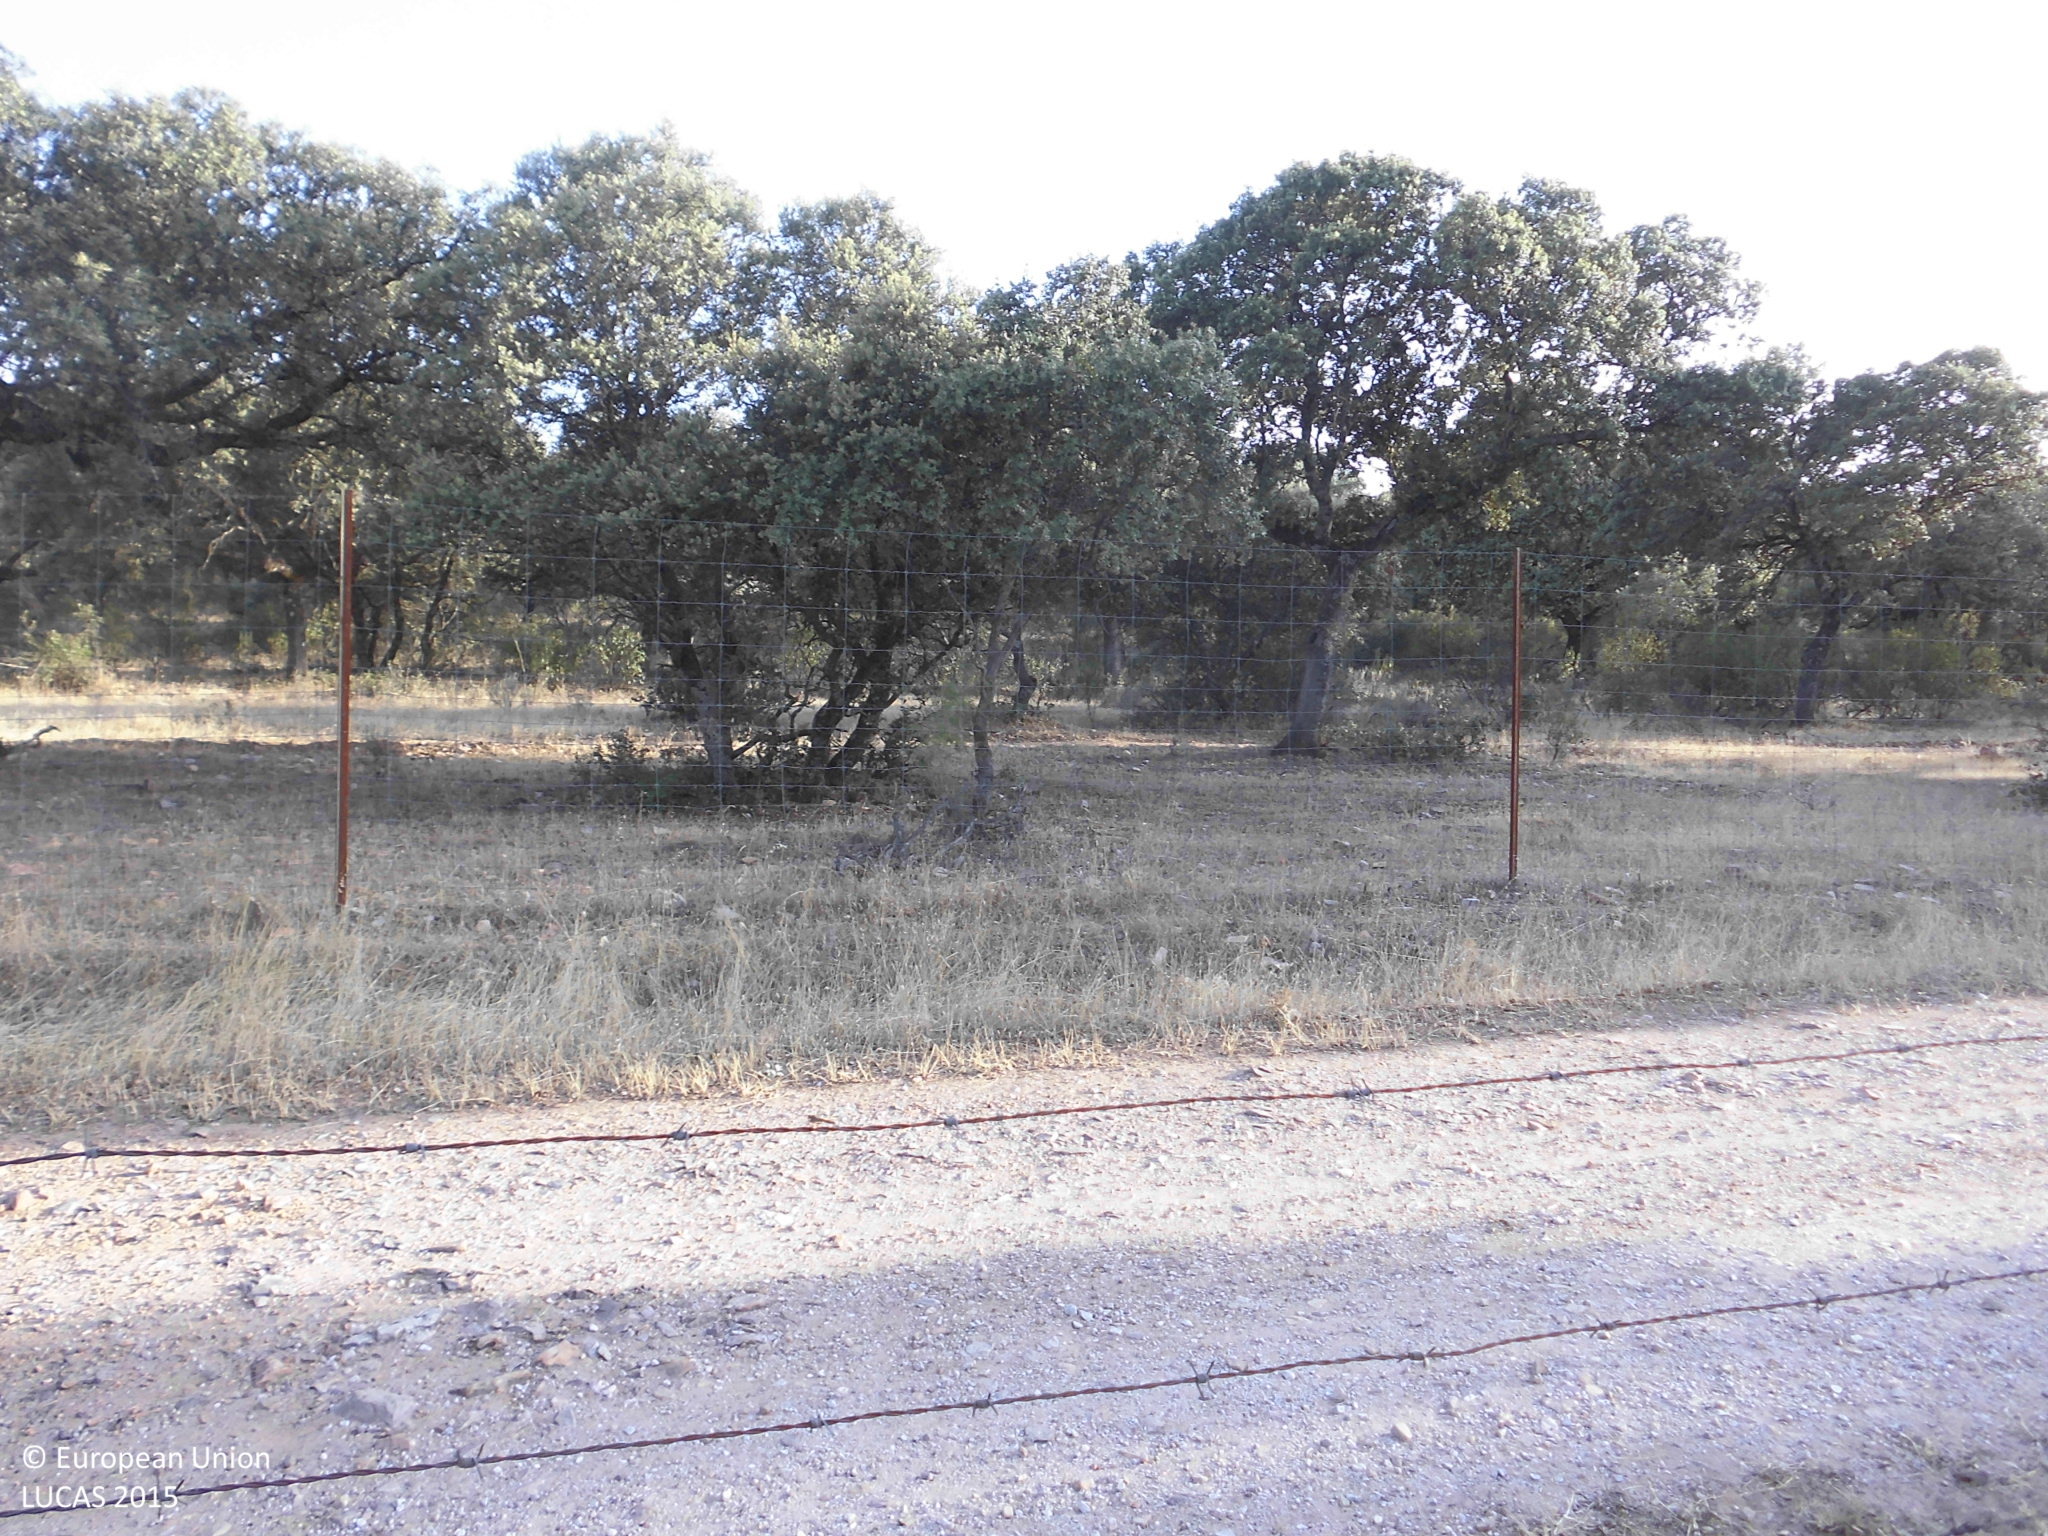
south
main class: Woodland
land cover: Broadleaved woodland
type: broadleaved evergreen forest
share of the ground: 10 - 25 %
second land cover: Grassland without tree/shrub cover
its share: > 75 %
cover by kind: herbaceous plants 65 %, broadleaved forest trees 25 %, unconsolidated bare surface 10 %
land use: Forestry
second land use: Agriculture (excluding fallow land and kitchen gardens)
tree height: > 5 m
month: July
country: ES
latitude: 39.8111
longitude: -5.6540
